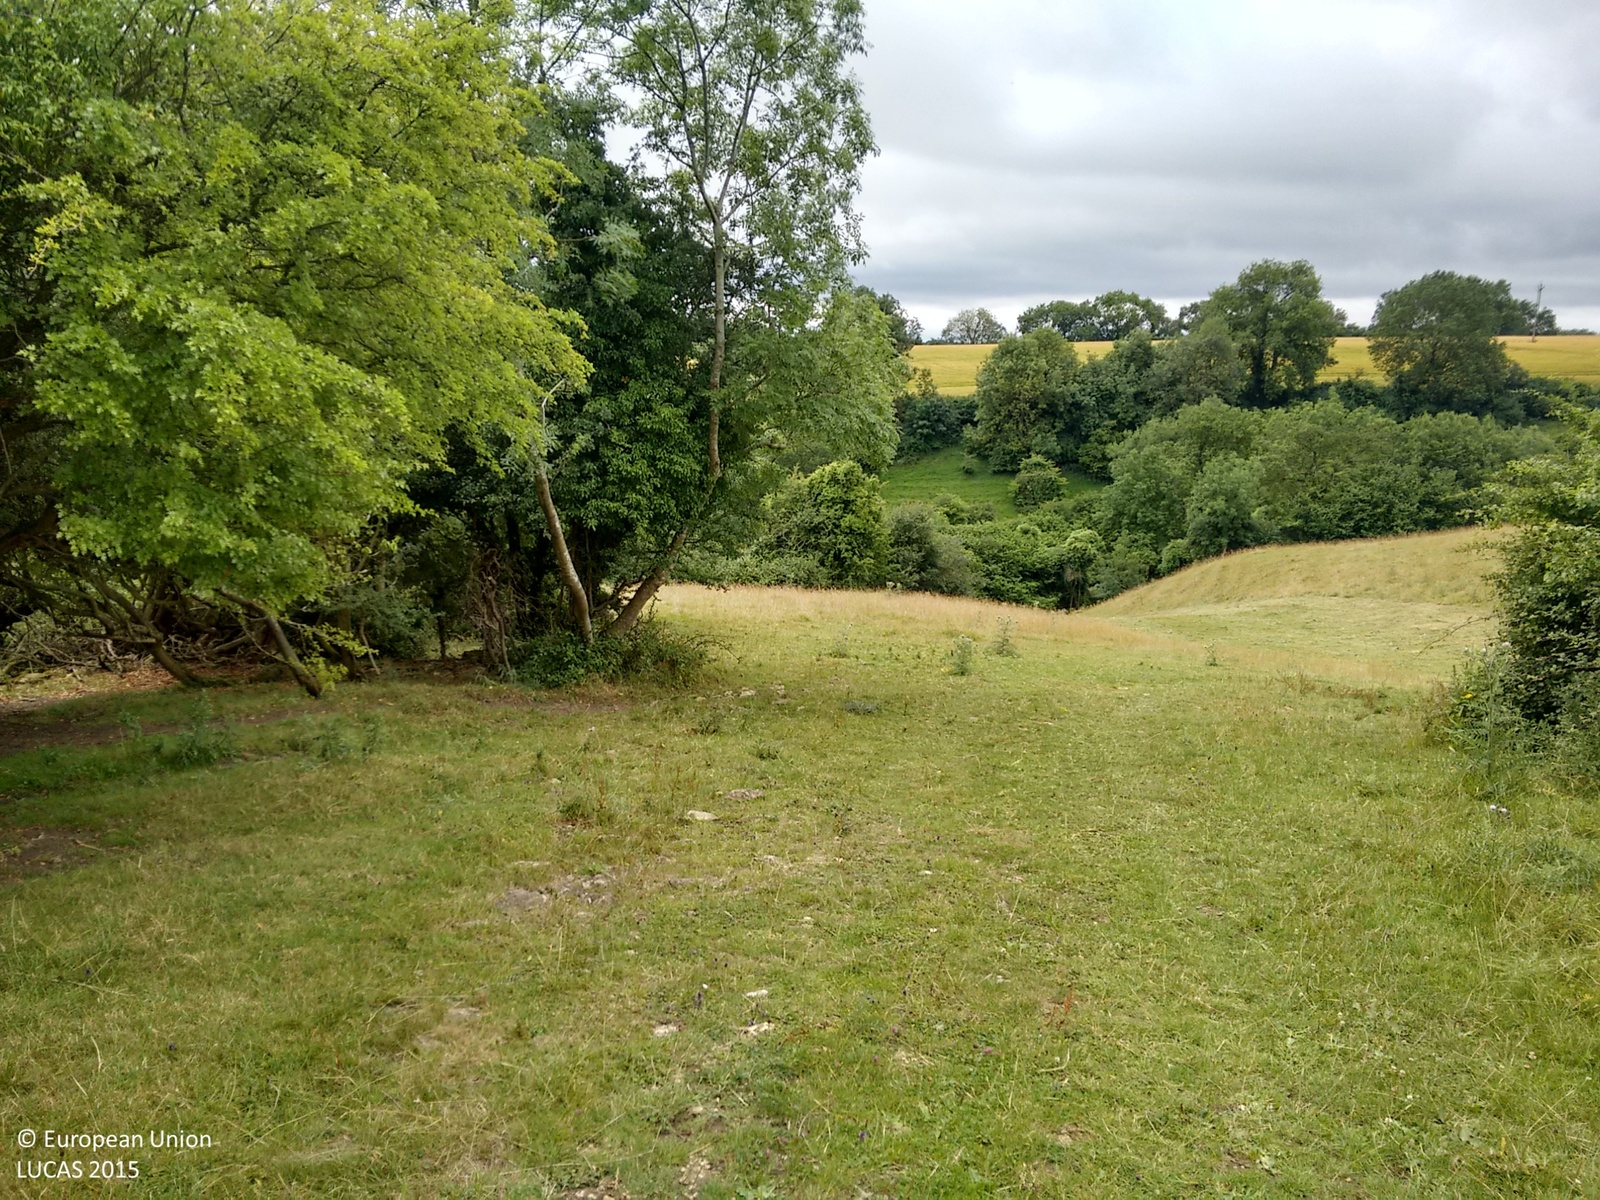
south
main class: Grassland
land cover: Grassland without tree/shrub cover
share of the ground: > 75 %
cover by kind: herbaceous plants 100 %
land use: Agriculture (excluding fallow land and kitchen gardens)
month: July
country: GB
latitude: 51.4576
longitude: -2.3403
